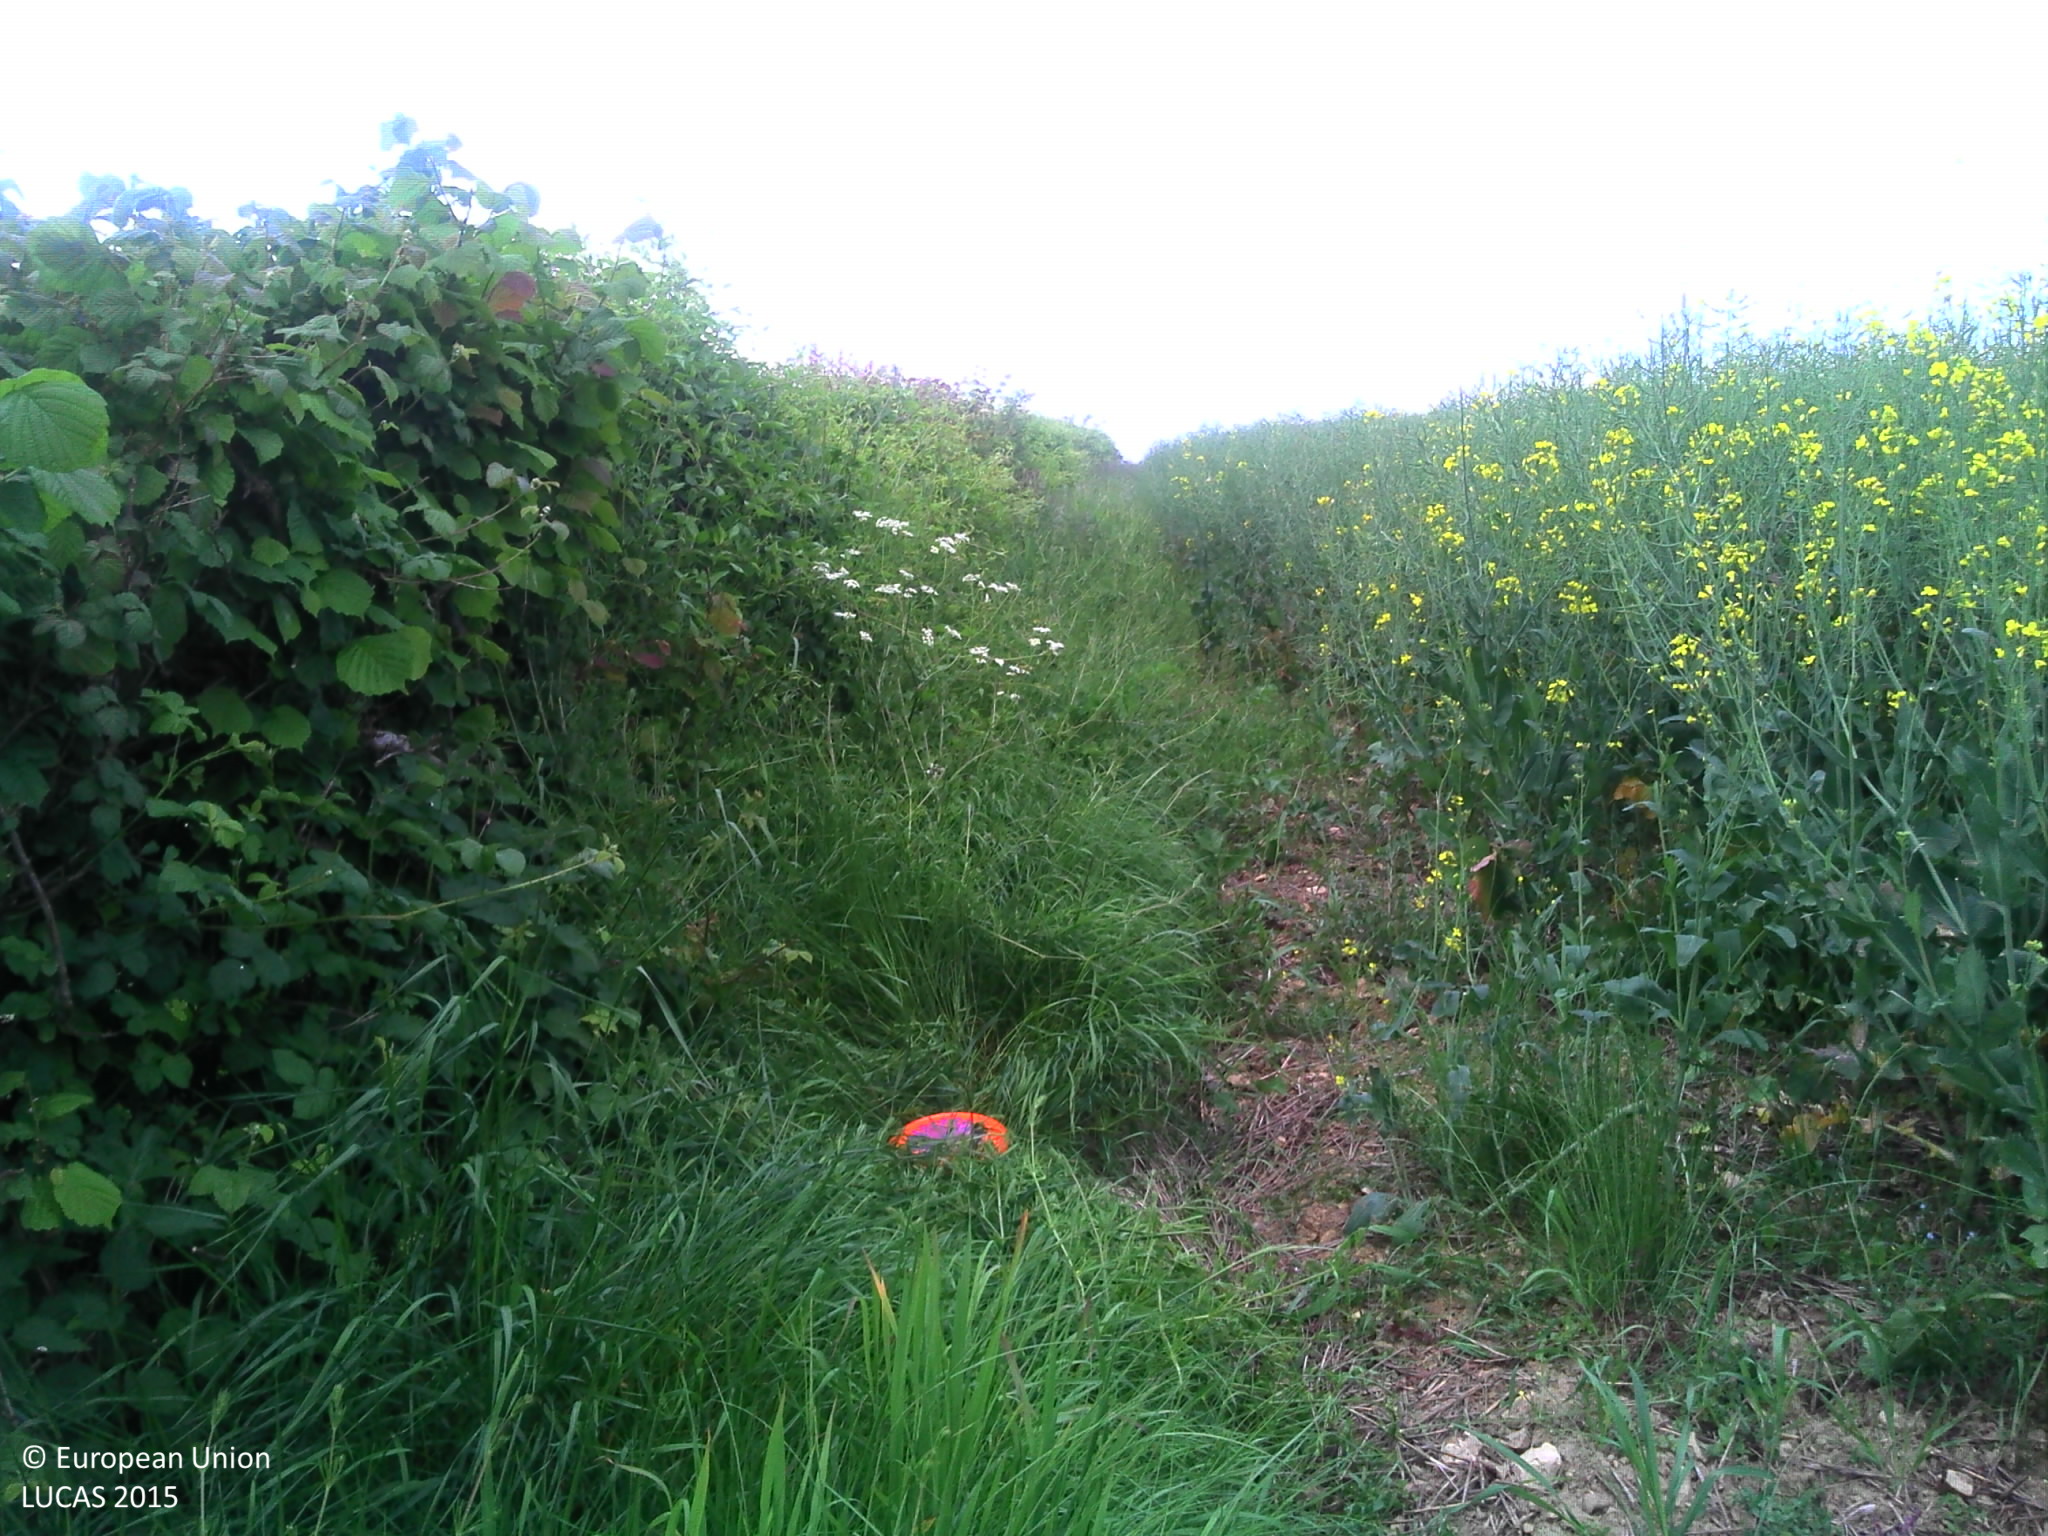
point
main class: Cropland
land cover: Rape and turnip rape
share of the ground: > 75 %
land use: Agriculture (excluding fallow land and kitchen gardens)
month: May
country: FR
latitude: 48.7677
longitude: -0.1681
